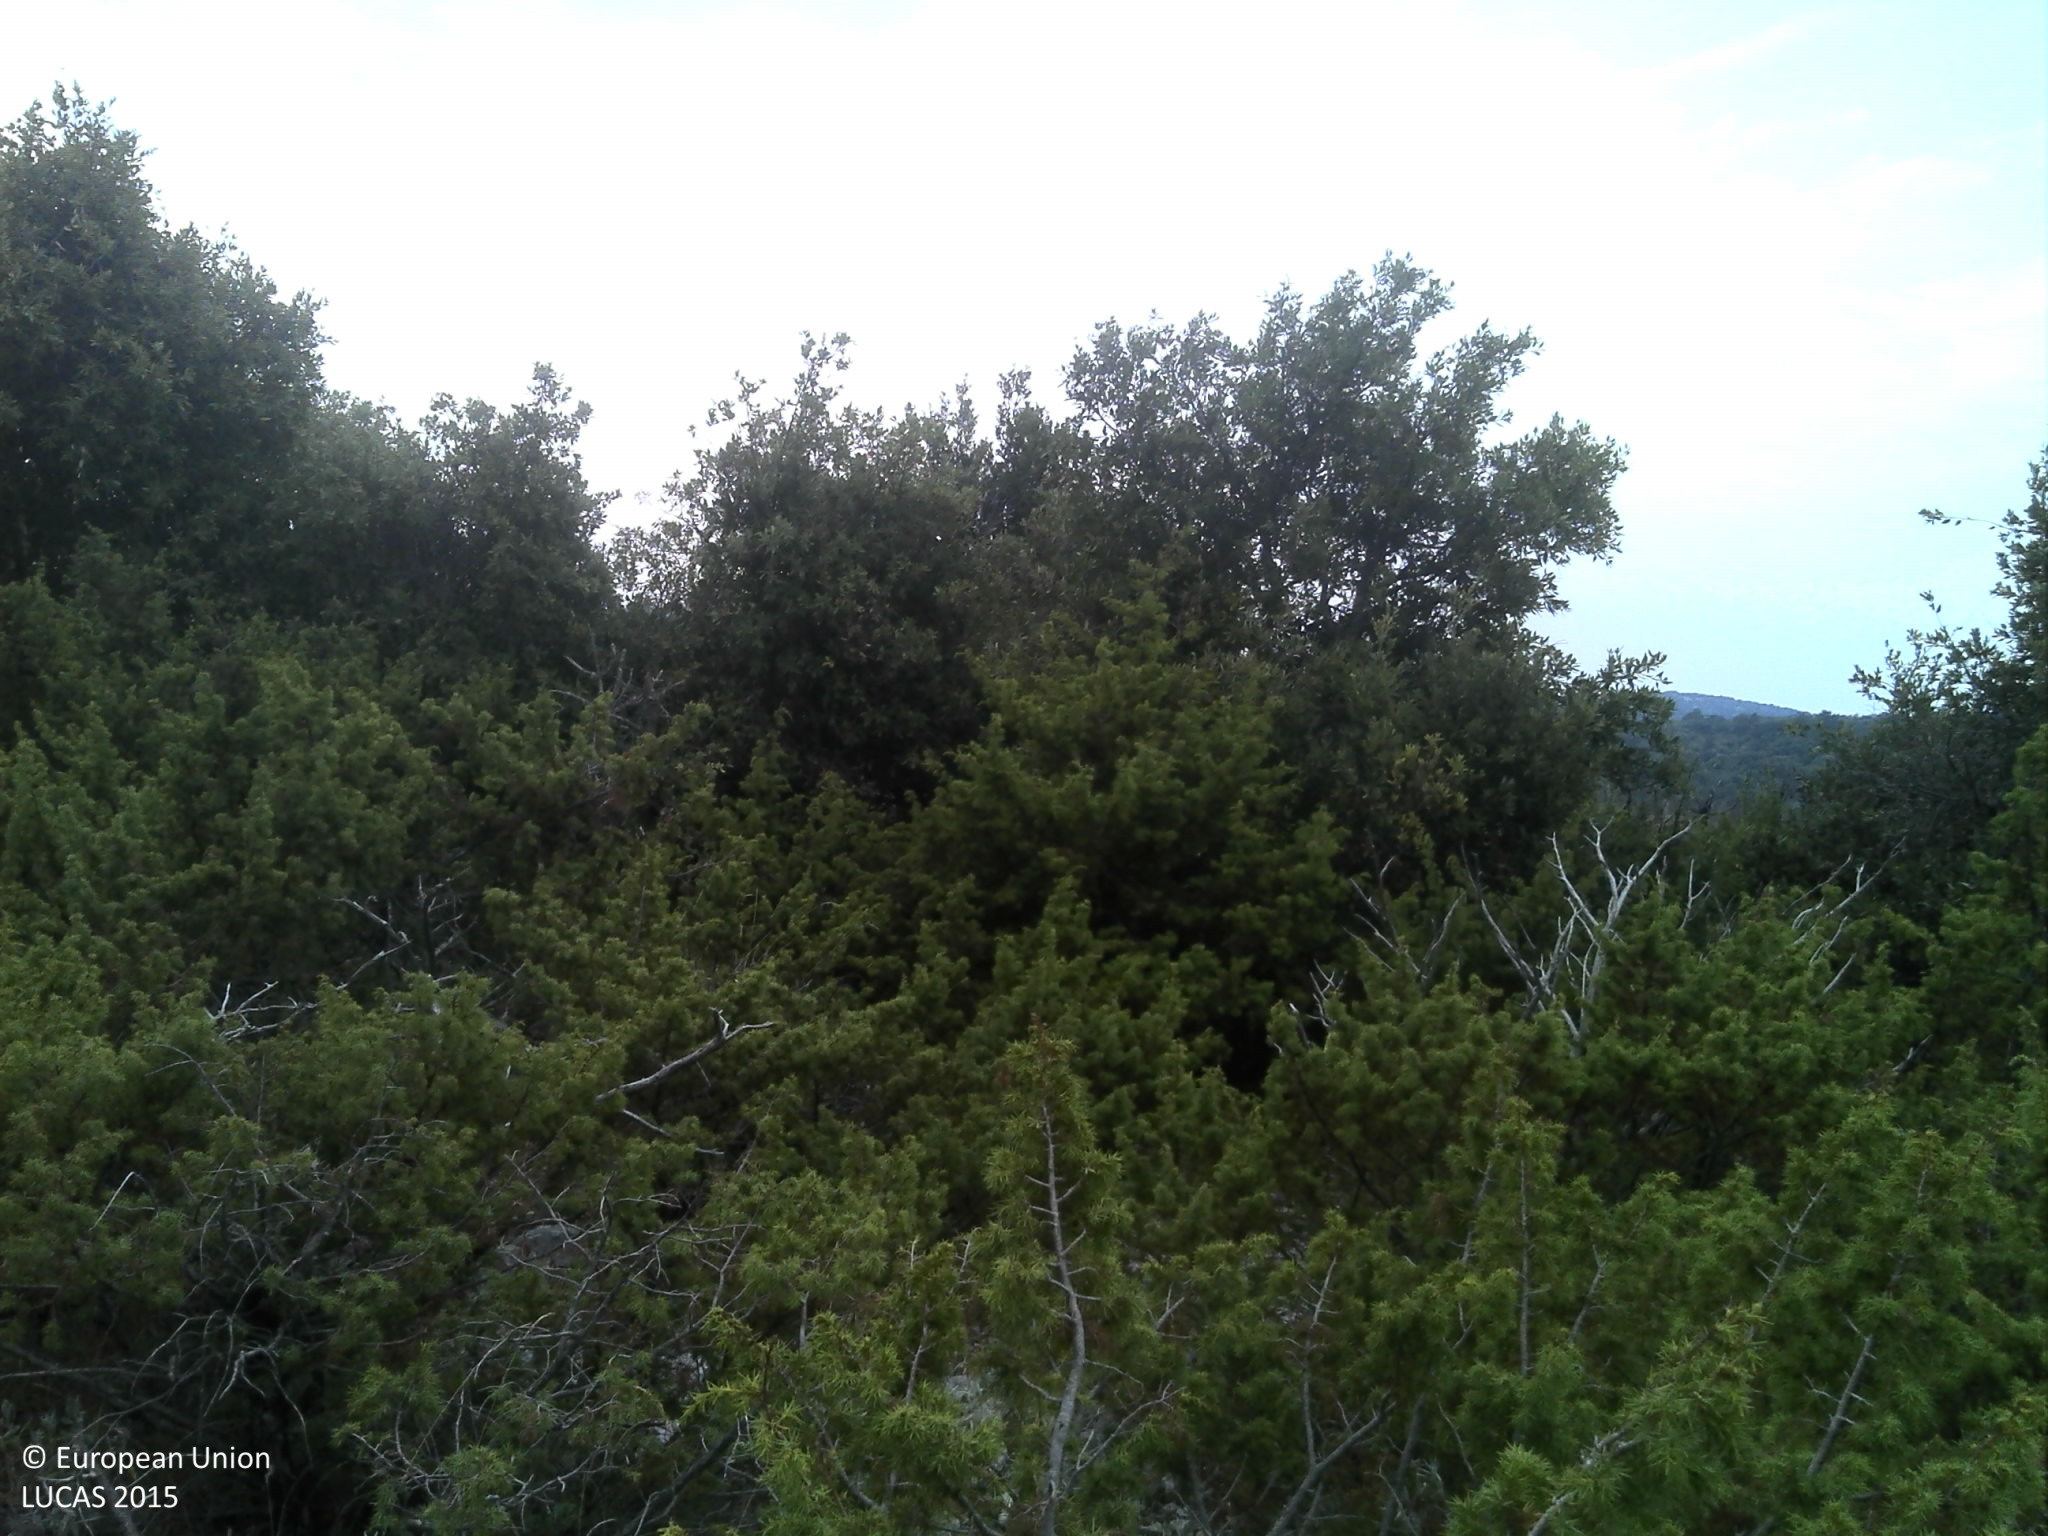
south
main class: Shrubland
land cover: Shrubland with sparse tree cover
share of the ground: > 75 %
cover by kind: shrubs 55 %, unconsolidated bare surface 20 %, herbaceous plants 15 %, broadleaved forest trees 5 %, consolidated bare surface 5 %
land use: Semi-natural and natural areas not in use
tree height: < 5 m
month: July
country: HR
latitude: 43.3104
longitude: 16.5614
